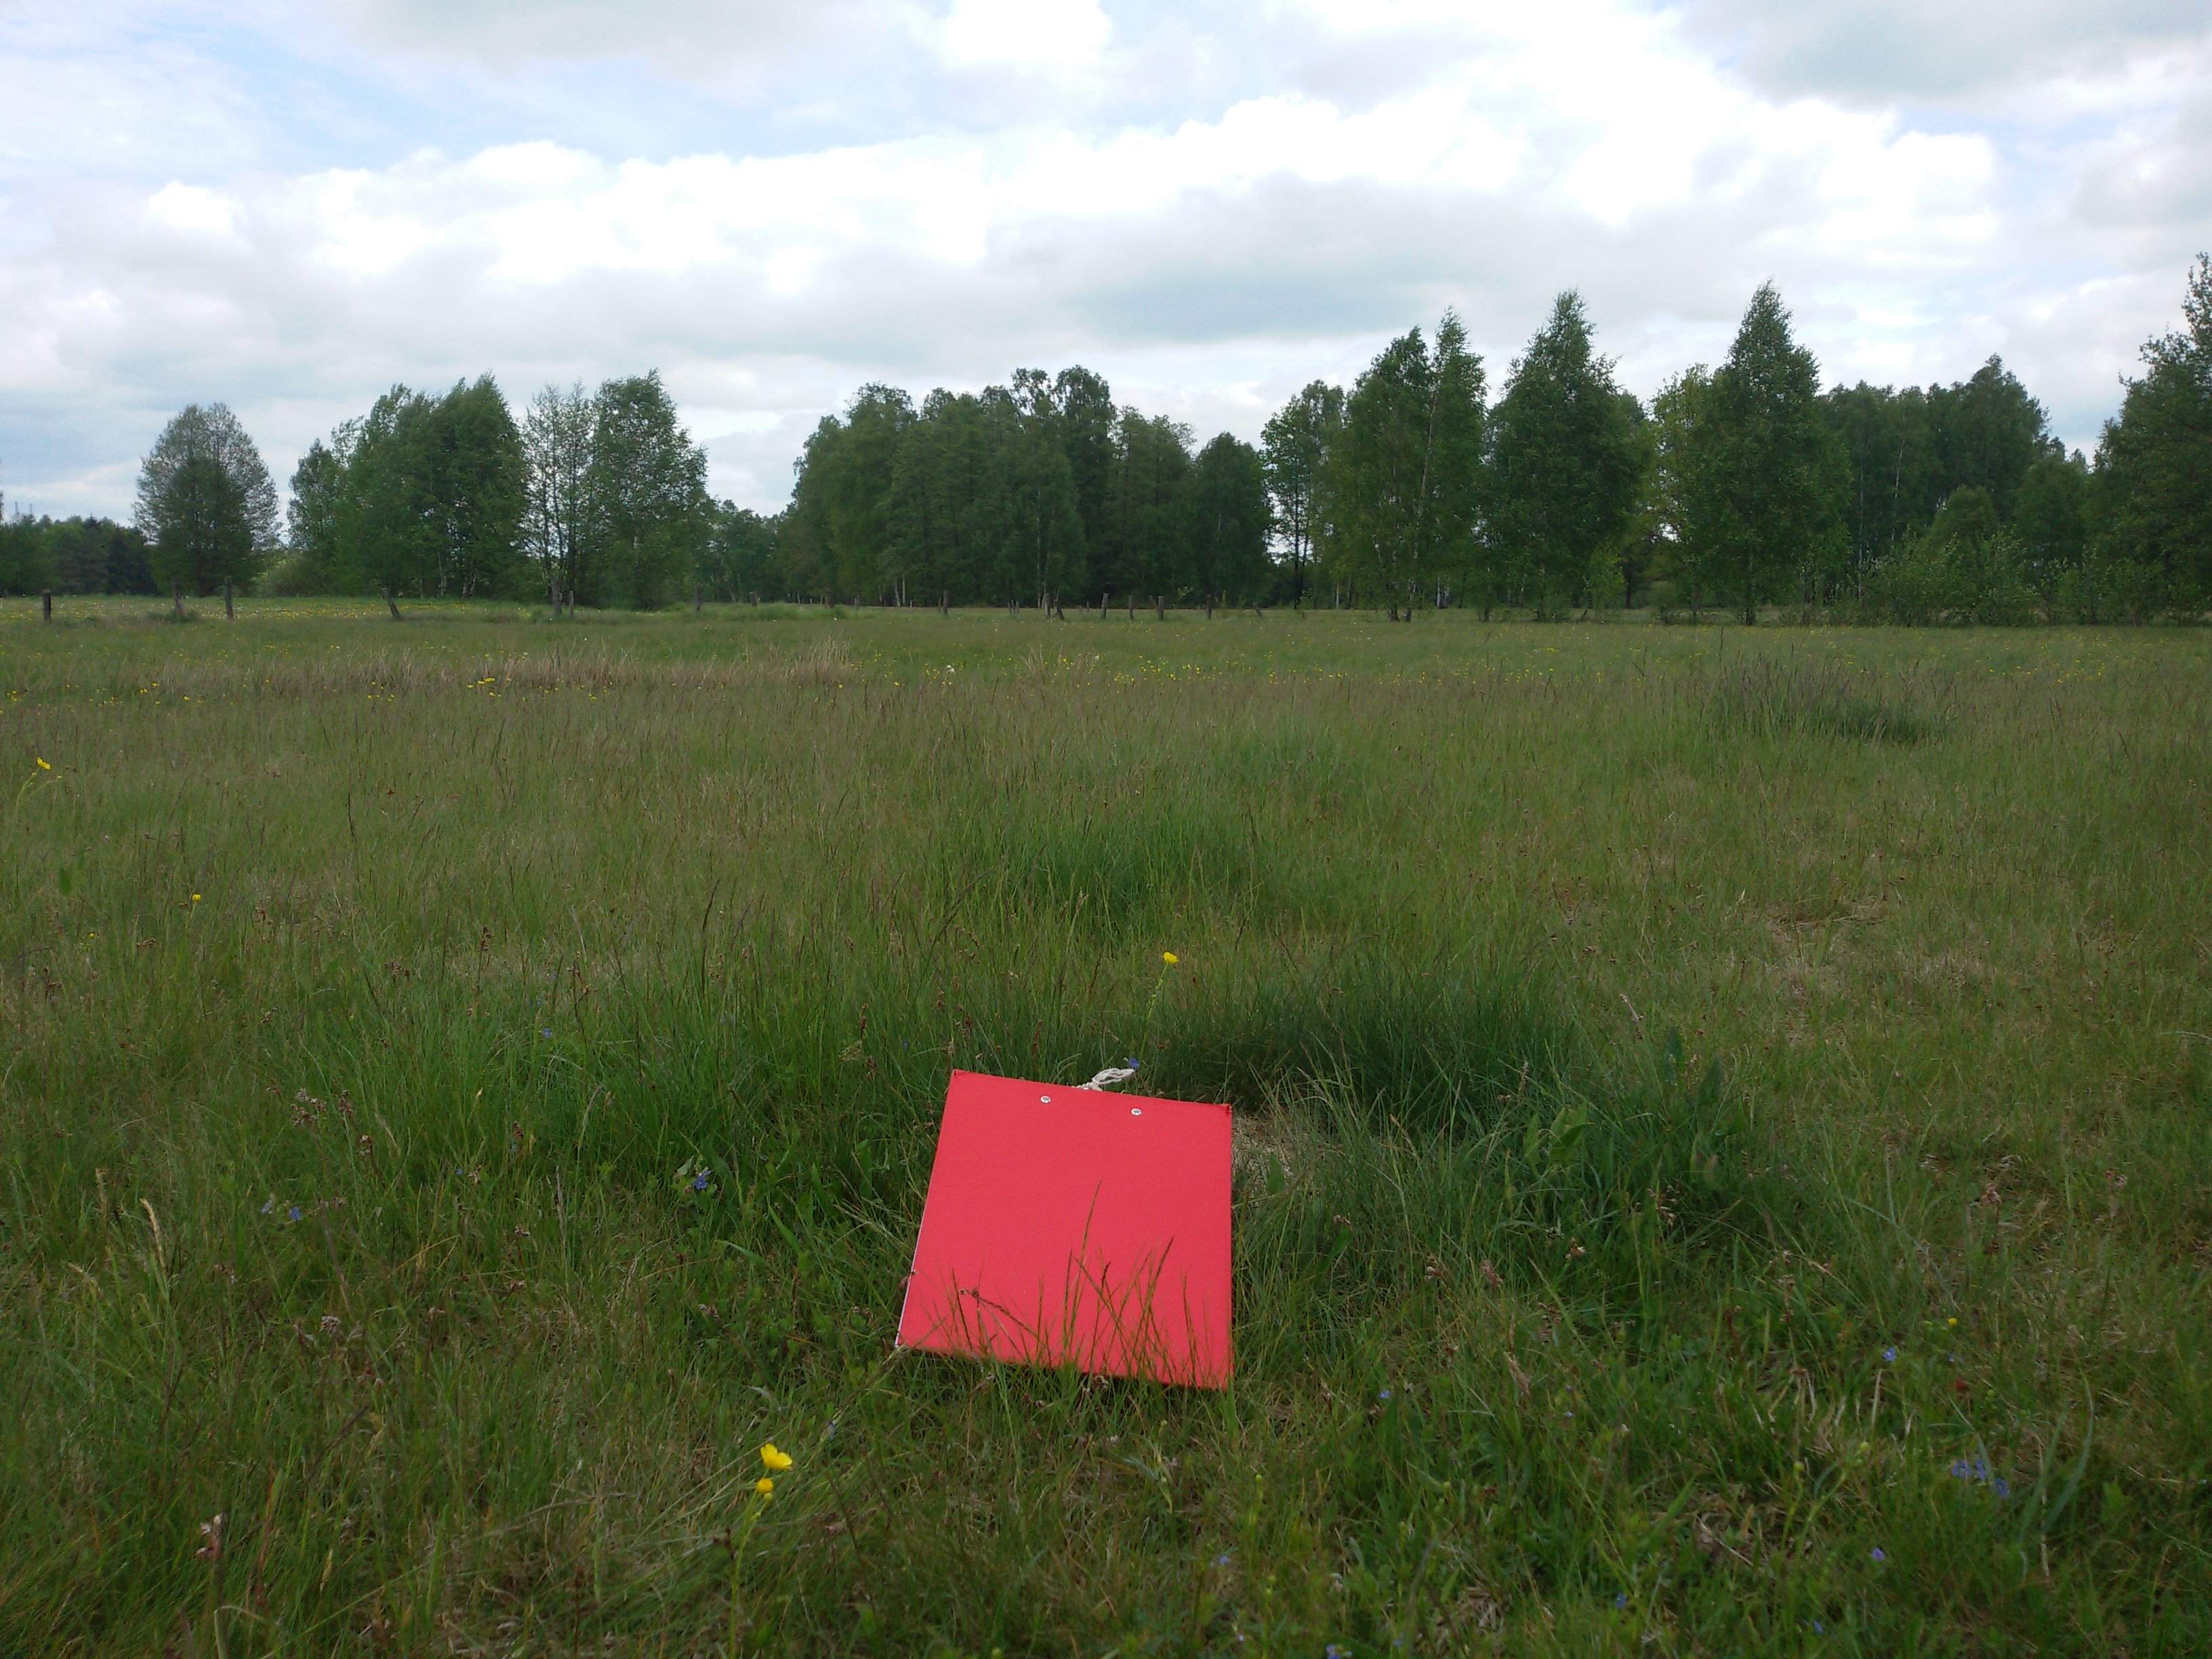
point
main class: Grassland
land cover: Grassland without tree/shrub cover
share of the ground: > 75 %
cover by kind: herbaceous plants 100 %
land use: Agriculture (excluding fallow land and kitchen gardens)
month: May
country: PL
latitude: 53.5129
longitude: 21.0372
